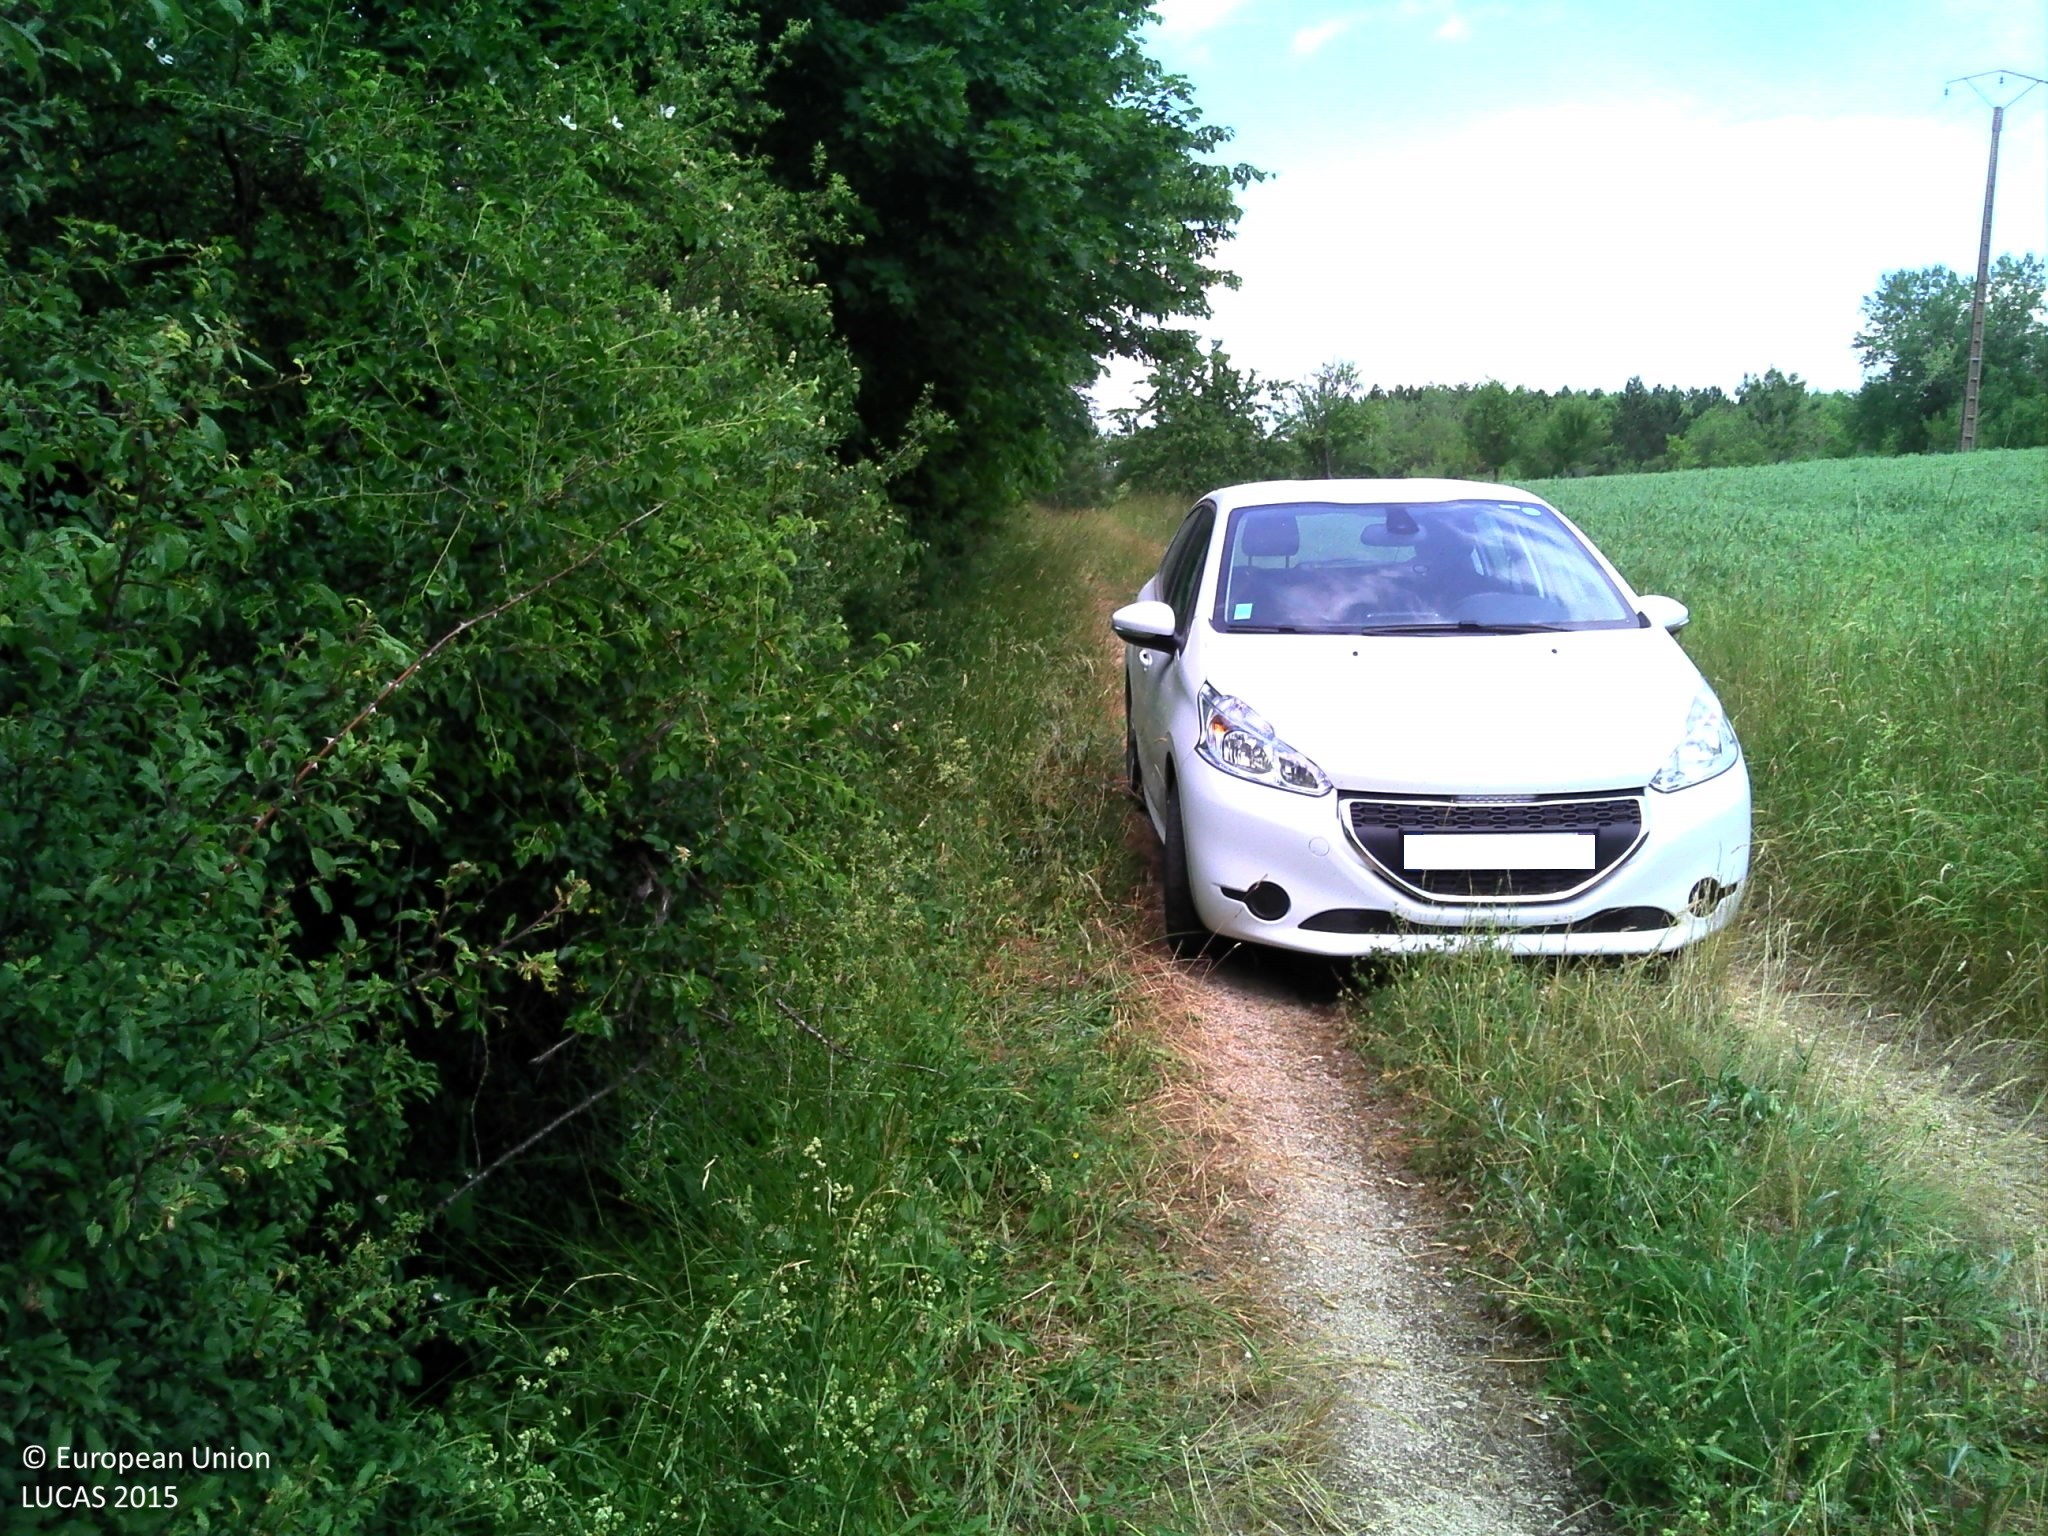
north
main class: Woodland
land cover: Broadleaved woodland
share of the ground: > 75 %
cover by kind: broadleaved forest trees 95 %, shrubs 5 %
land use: Semi-natural and natural areas not in use
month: June
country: FR
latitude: 47.5962
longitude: 5.1991
